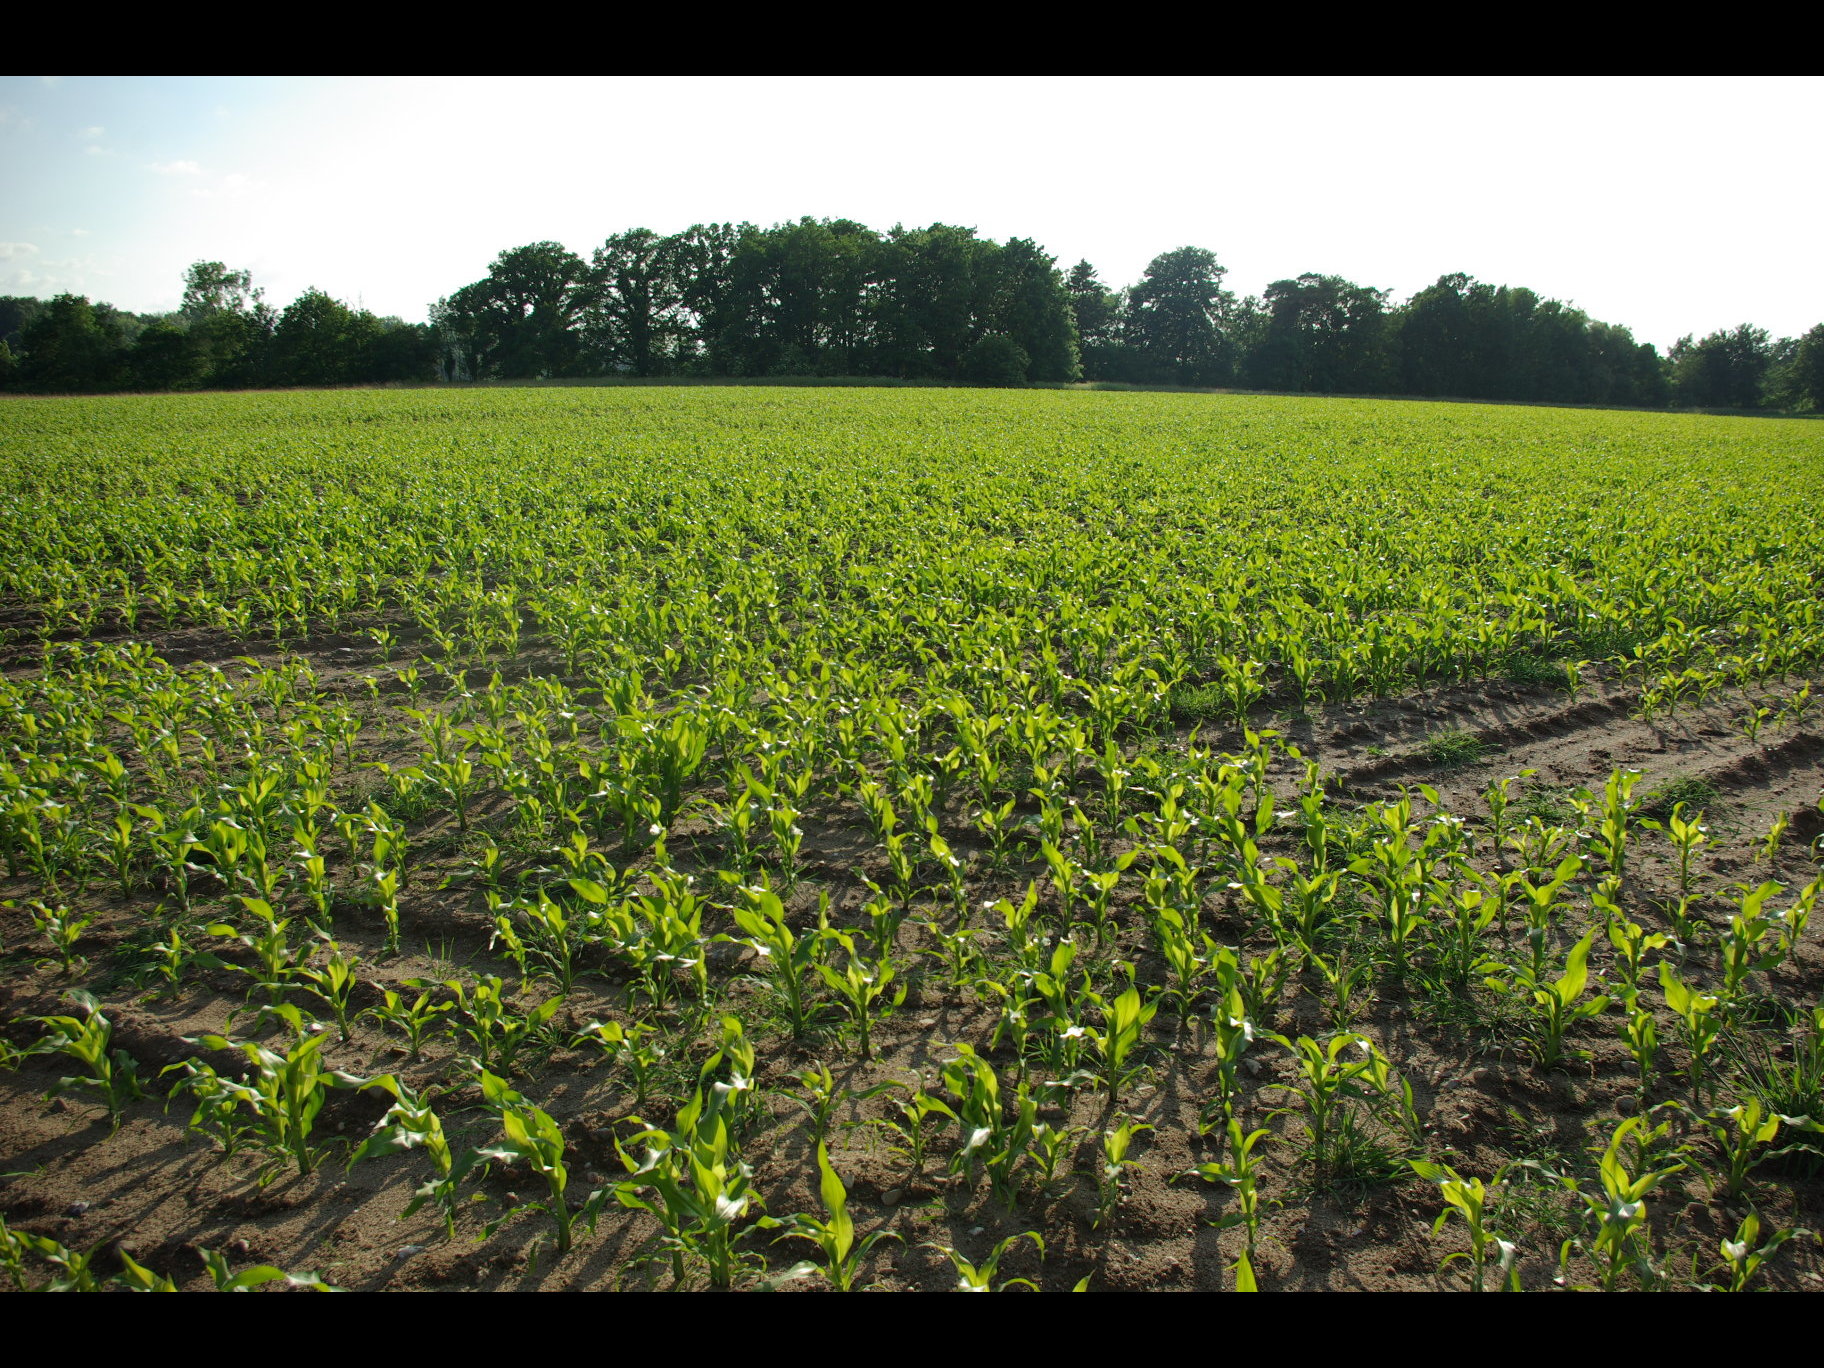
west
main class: Cropland
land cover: Maize
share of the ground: 25 - 50 %
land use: Agriculture (excluding fallow land and kitchen gardens)
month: June
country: DE
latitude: 54.2106
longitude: 9.8927
